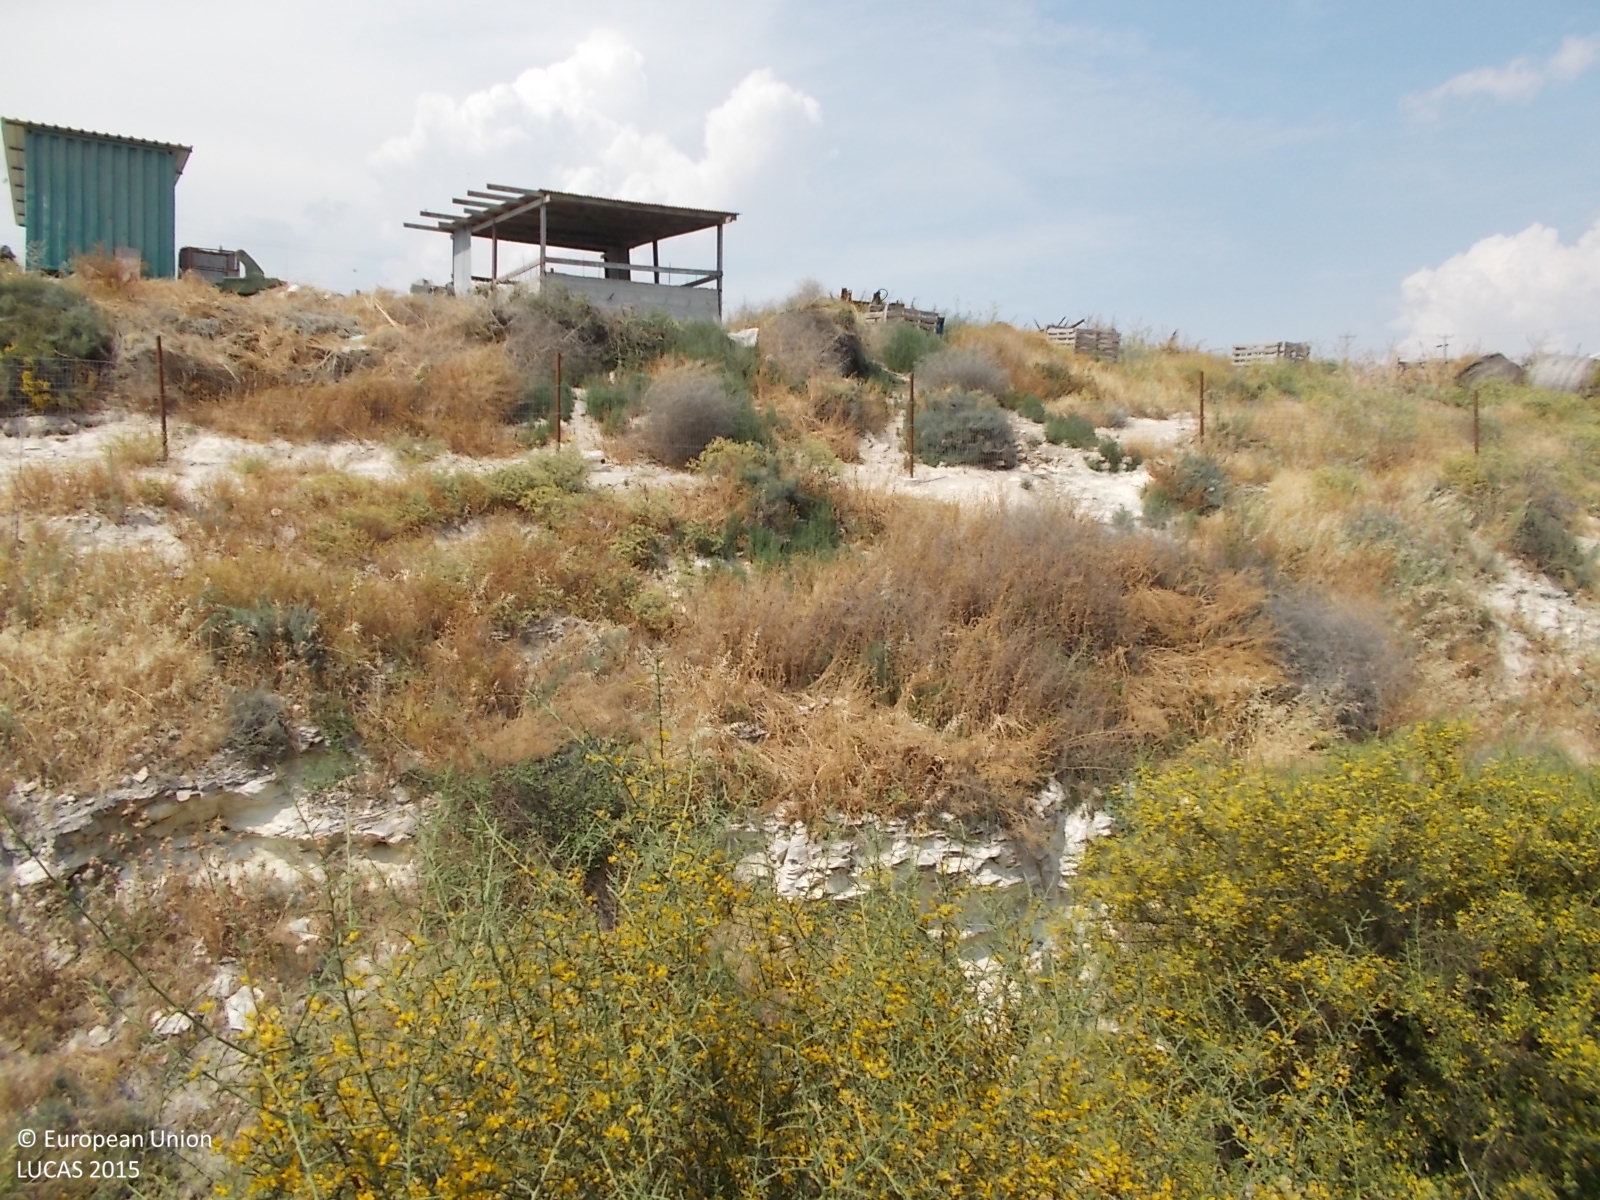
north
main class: Shrubland
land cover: Shrubland without tree cover
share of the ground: > 75 %
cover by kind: shrubs 80 %, herbaceous plants 10 %, unconsolidated bare surface 10 %
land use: Semi-natural and natural areas not in use
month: May
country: CY
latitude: 34.8879
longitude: 33.5075
